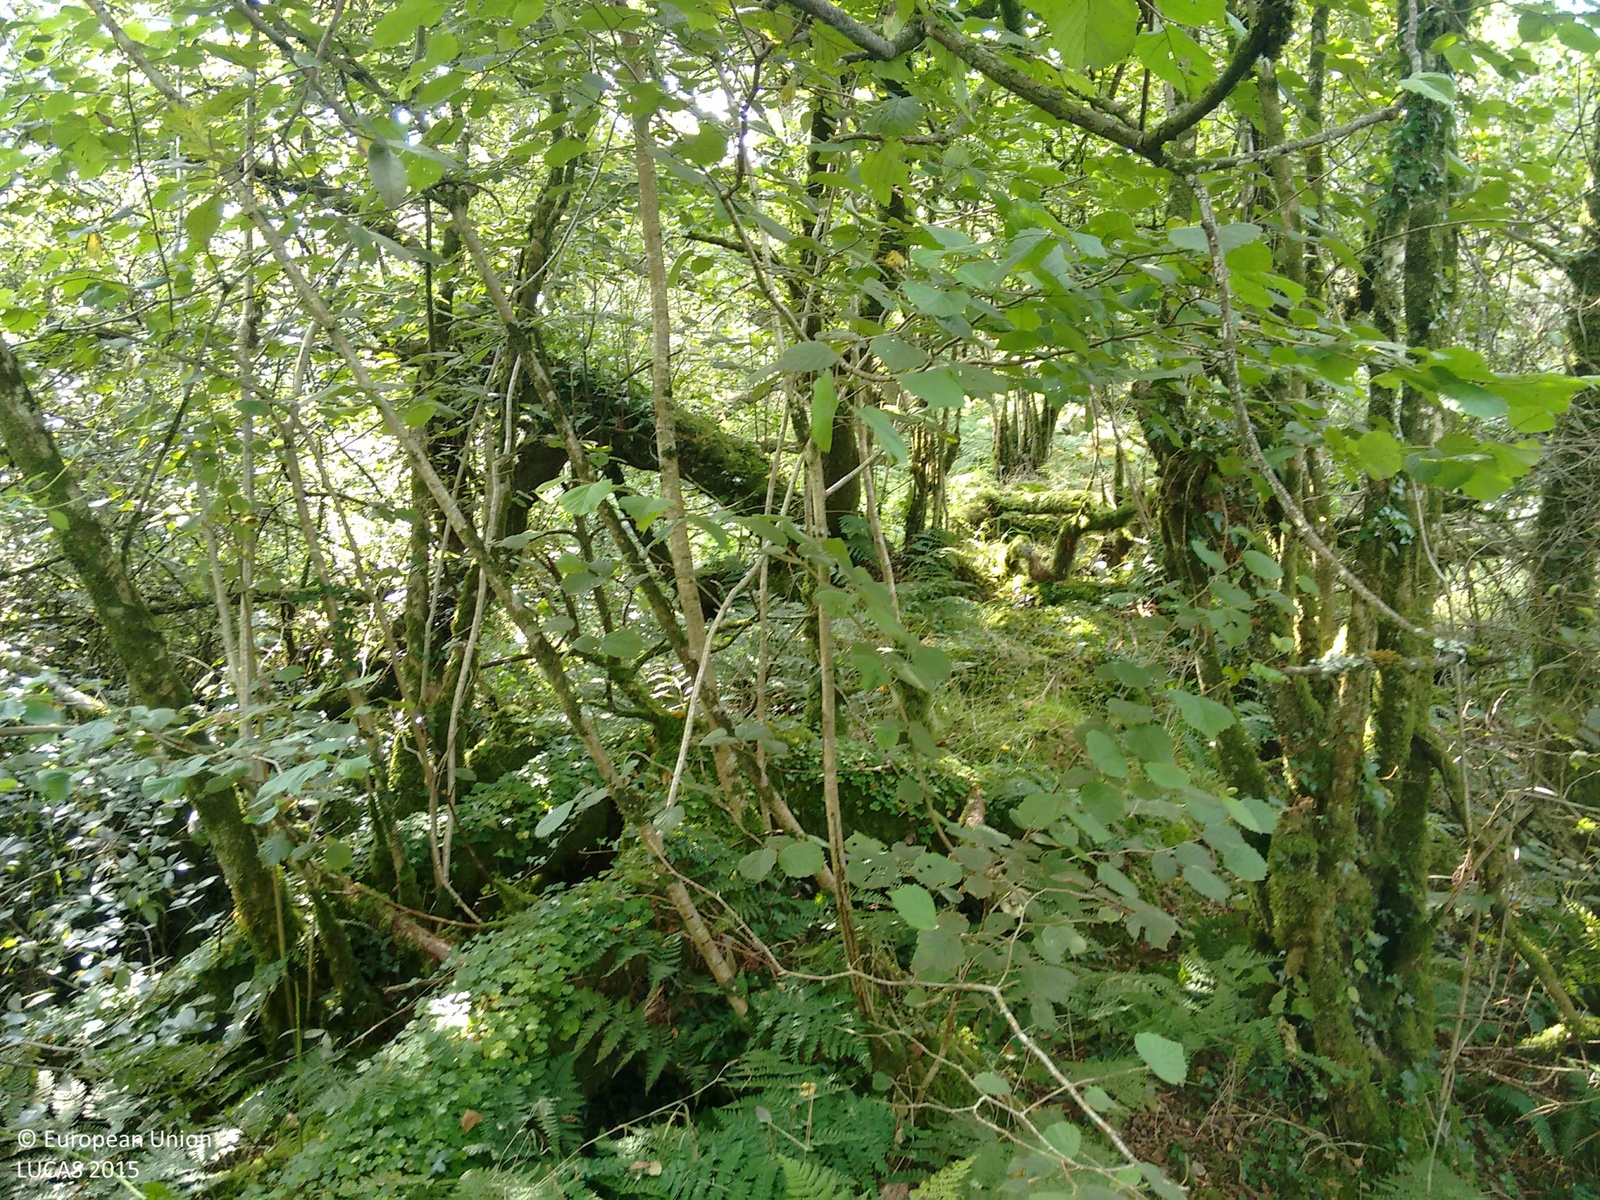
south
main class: Woodland
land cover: Broadleaved woodland
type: mesophytic deciduous forest
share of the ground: > 75 %
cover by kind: broadleaved forest trees 100 %
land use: Semi-natural and natural areas not in use
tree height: > 5 m
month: September
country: GB
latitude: 50.9265
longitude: -4.4011
